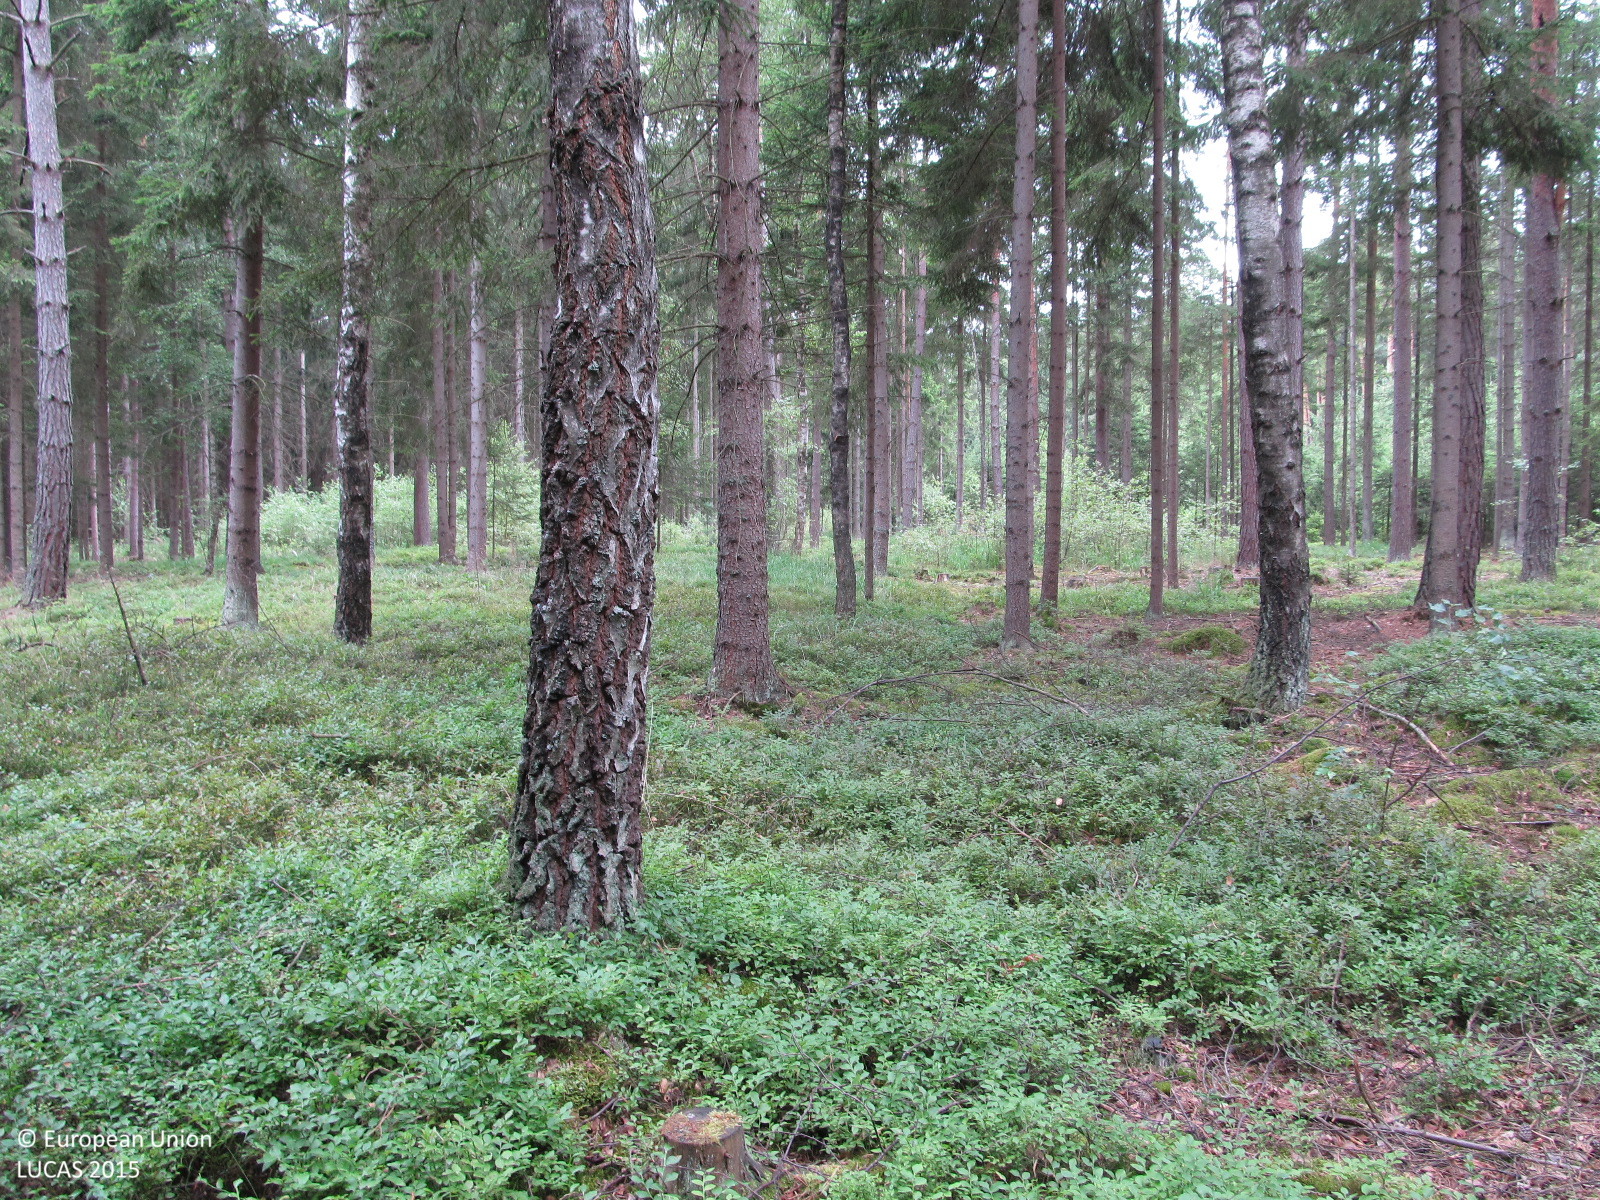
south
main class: Woodland
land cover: Spruce dominated coniferous woodland
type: hemiboreal forest and nemoral coniferous forest and mixed broadleaved-coniferous forest
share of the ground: > 75 %
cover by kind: coniferous forest trees 85 %, shrubs 5 %, herbaceous plants 5 %, lichens and mosses 5 %
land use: Forestry
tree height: > 5 m
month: July
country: AT
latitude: 48.7581
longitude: 15.0214
